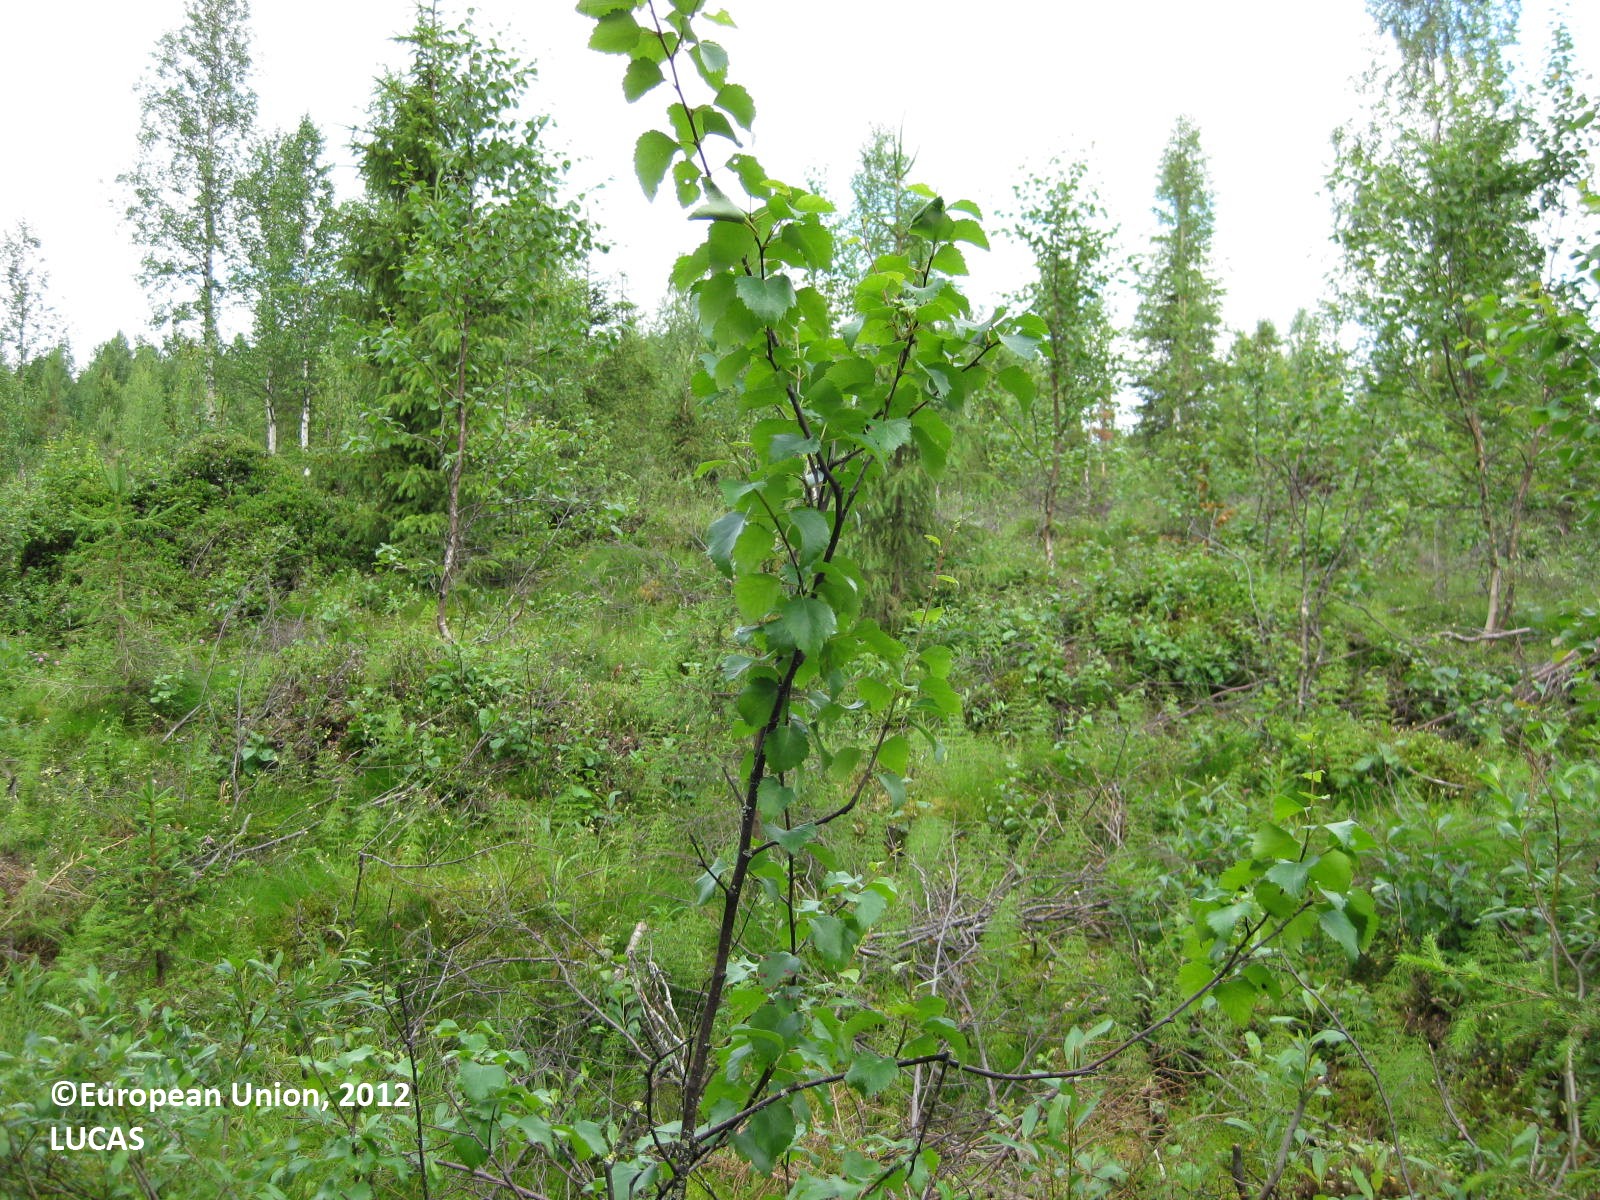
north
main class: Woodland
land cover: Spruce dominated mixed woodland
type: boreal forest
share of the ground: 50 - 75 %
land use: Forestry
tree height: < 5 m
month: July
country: FI
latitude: 65.5617
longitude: 28.2847
